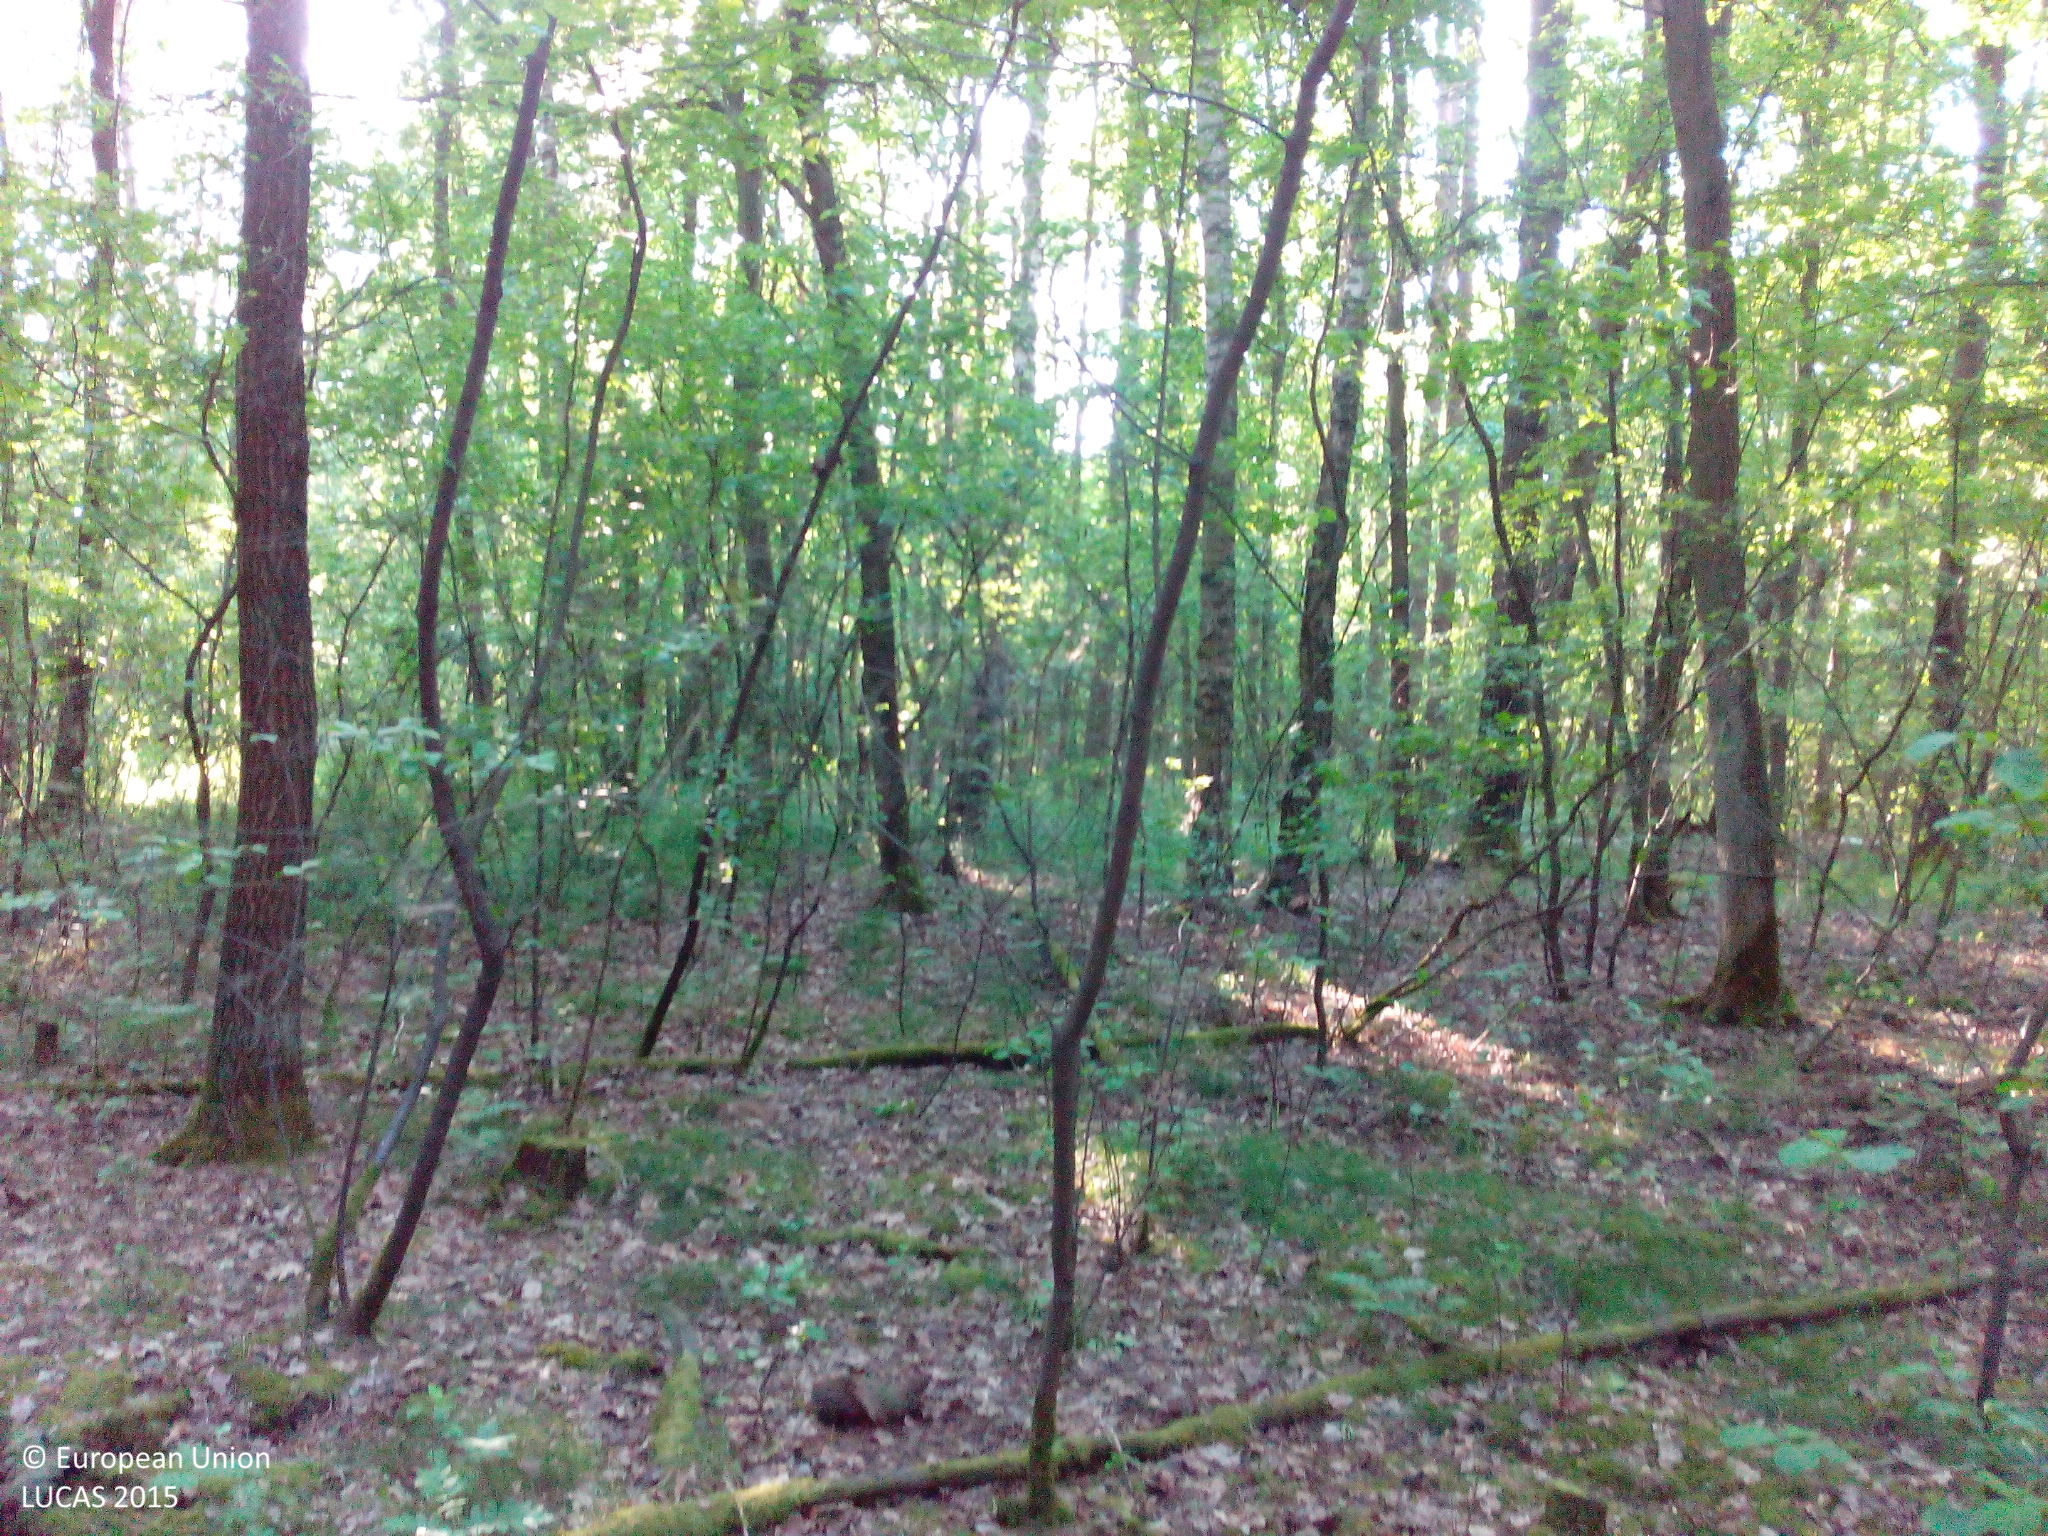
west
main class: Woodland
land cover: Pine dominated coniferous woodland
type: hemiboreal forest and nemoral coniferous forest and mixed broadleaved-coniferous forest
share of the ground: 50 - 75 %
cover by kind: coniferous forest trees 50 %, broadleaved forest trees 15 %, herbaceous plants 15 %, lichens and mosses 10 %, shrubs 5 %, unconsolidated bare surface 5 %
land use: Forestry
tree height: > 5 m
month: June
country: DE
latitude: 53.2353
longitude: 12.3516
